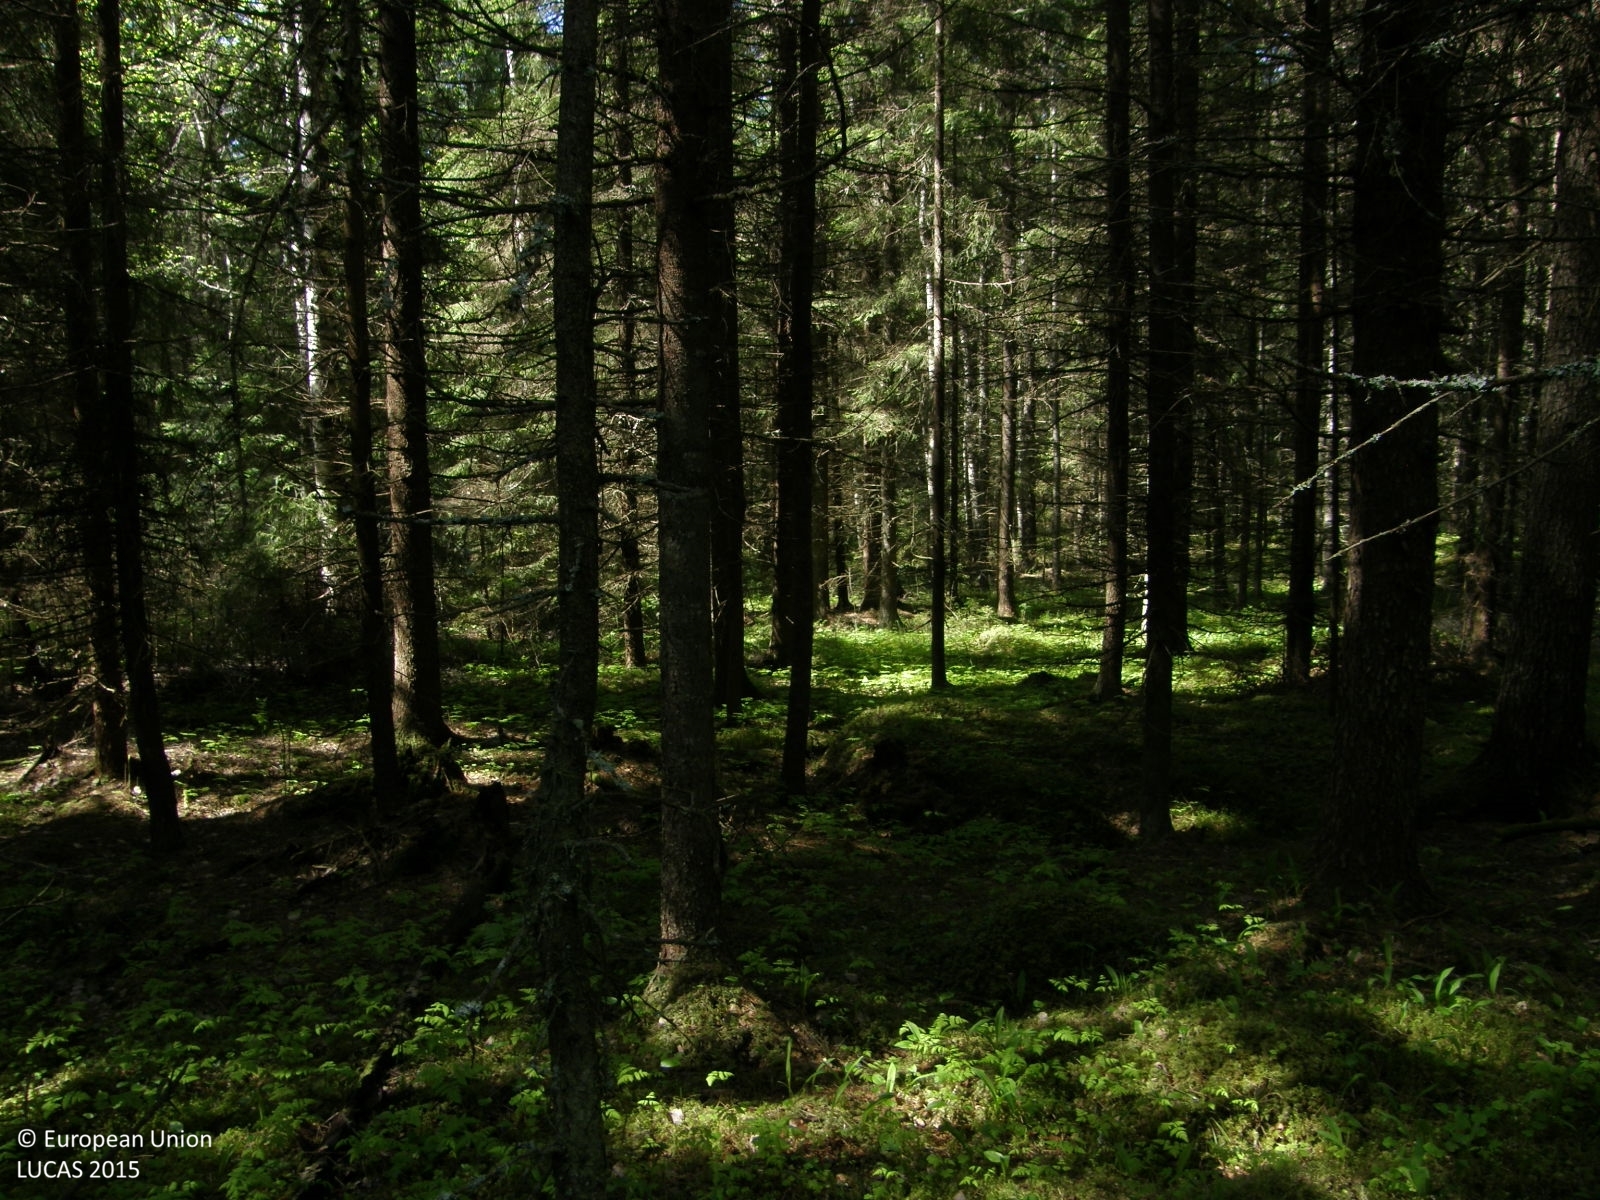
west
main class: Woodland
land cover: Spruce dominated coniferous woodland
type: boreal forest
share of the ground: > 75 %
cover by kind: coniferous forest trees 75 %, broadleaved forest trees 15 %, herbaceous plants 5 %, lichens and mosses 5 %
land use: Forestry
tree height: > 5 m
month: June
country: FI
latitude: 62.1341
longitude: 21.4953
